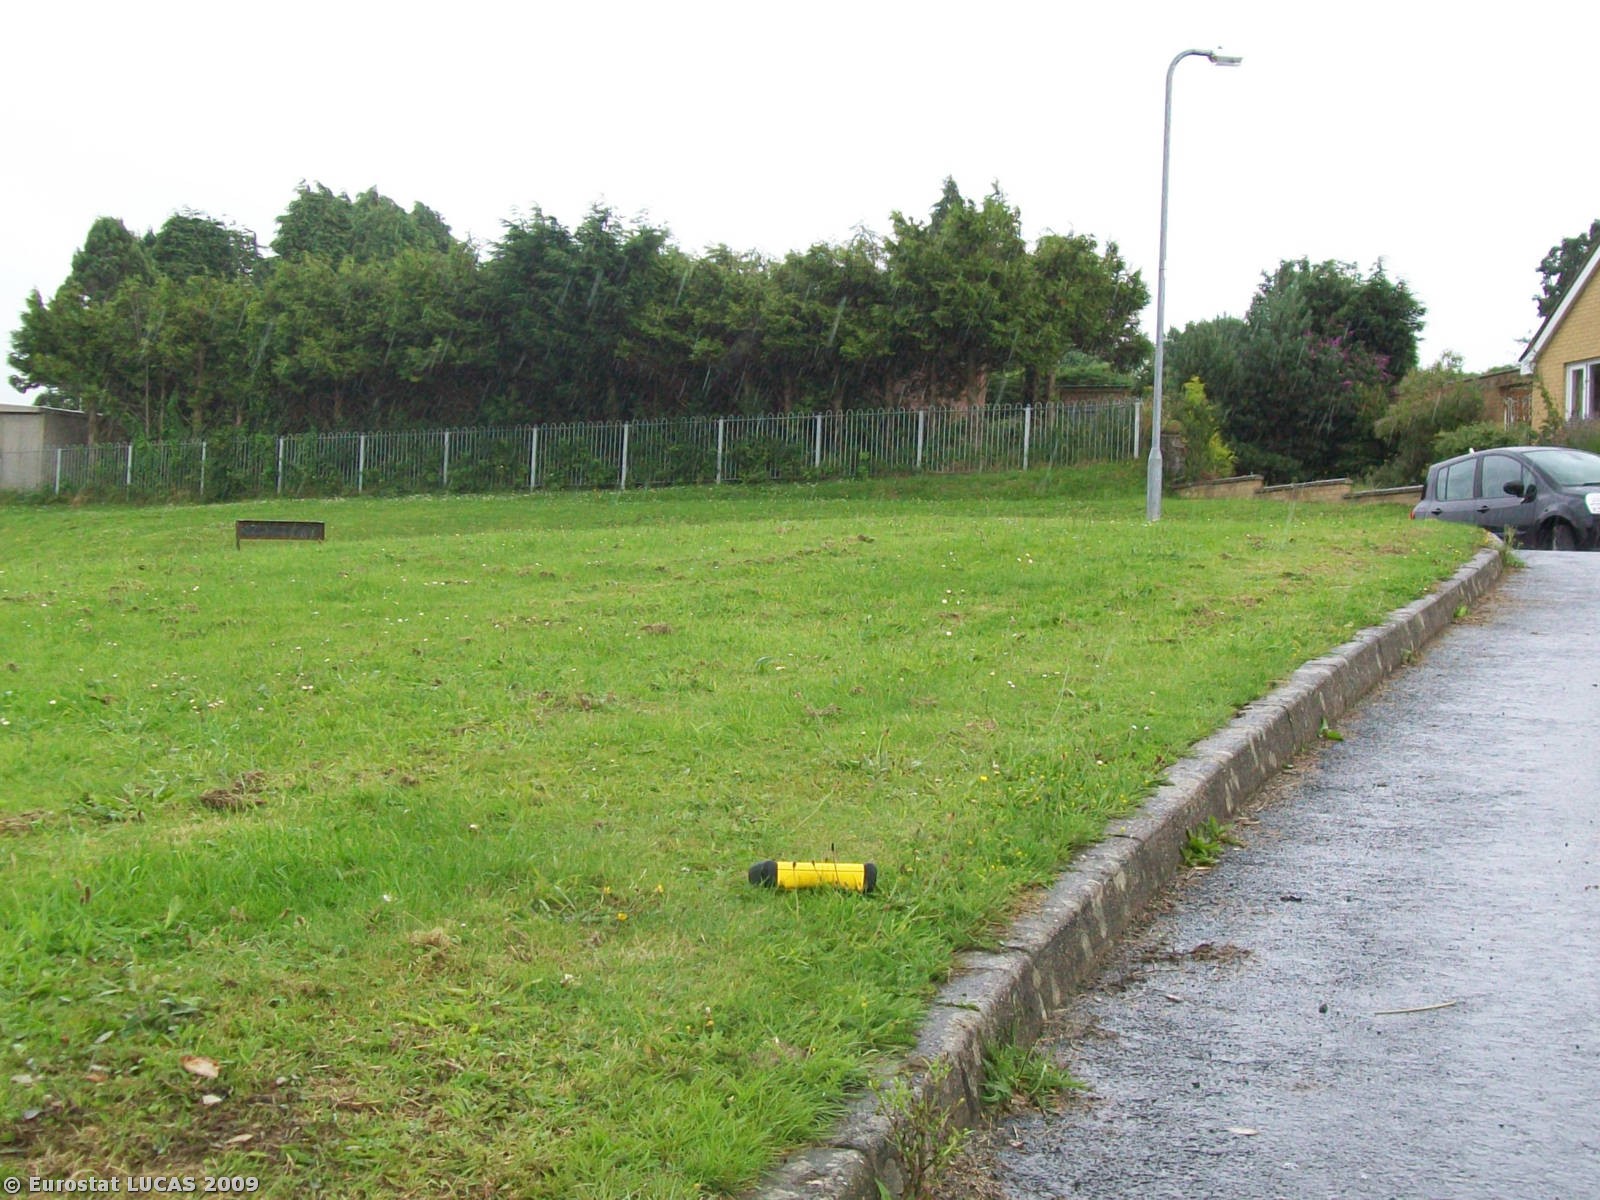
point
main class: Artificial land
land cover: Non built-up linear features
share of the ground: > 75 %
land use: Road transport
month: July
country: GB
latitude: 51.8035
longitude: -4.9815
